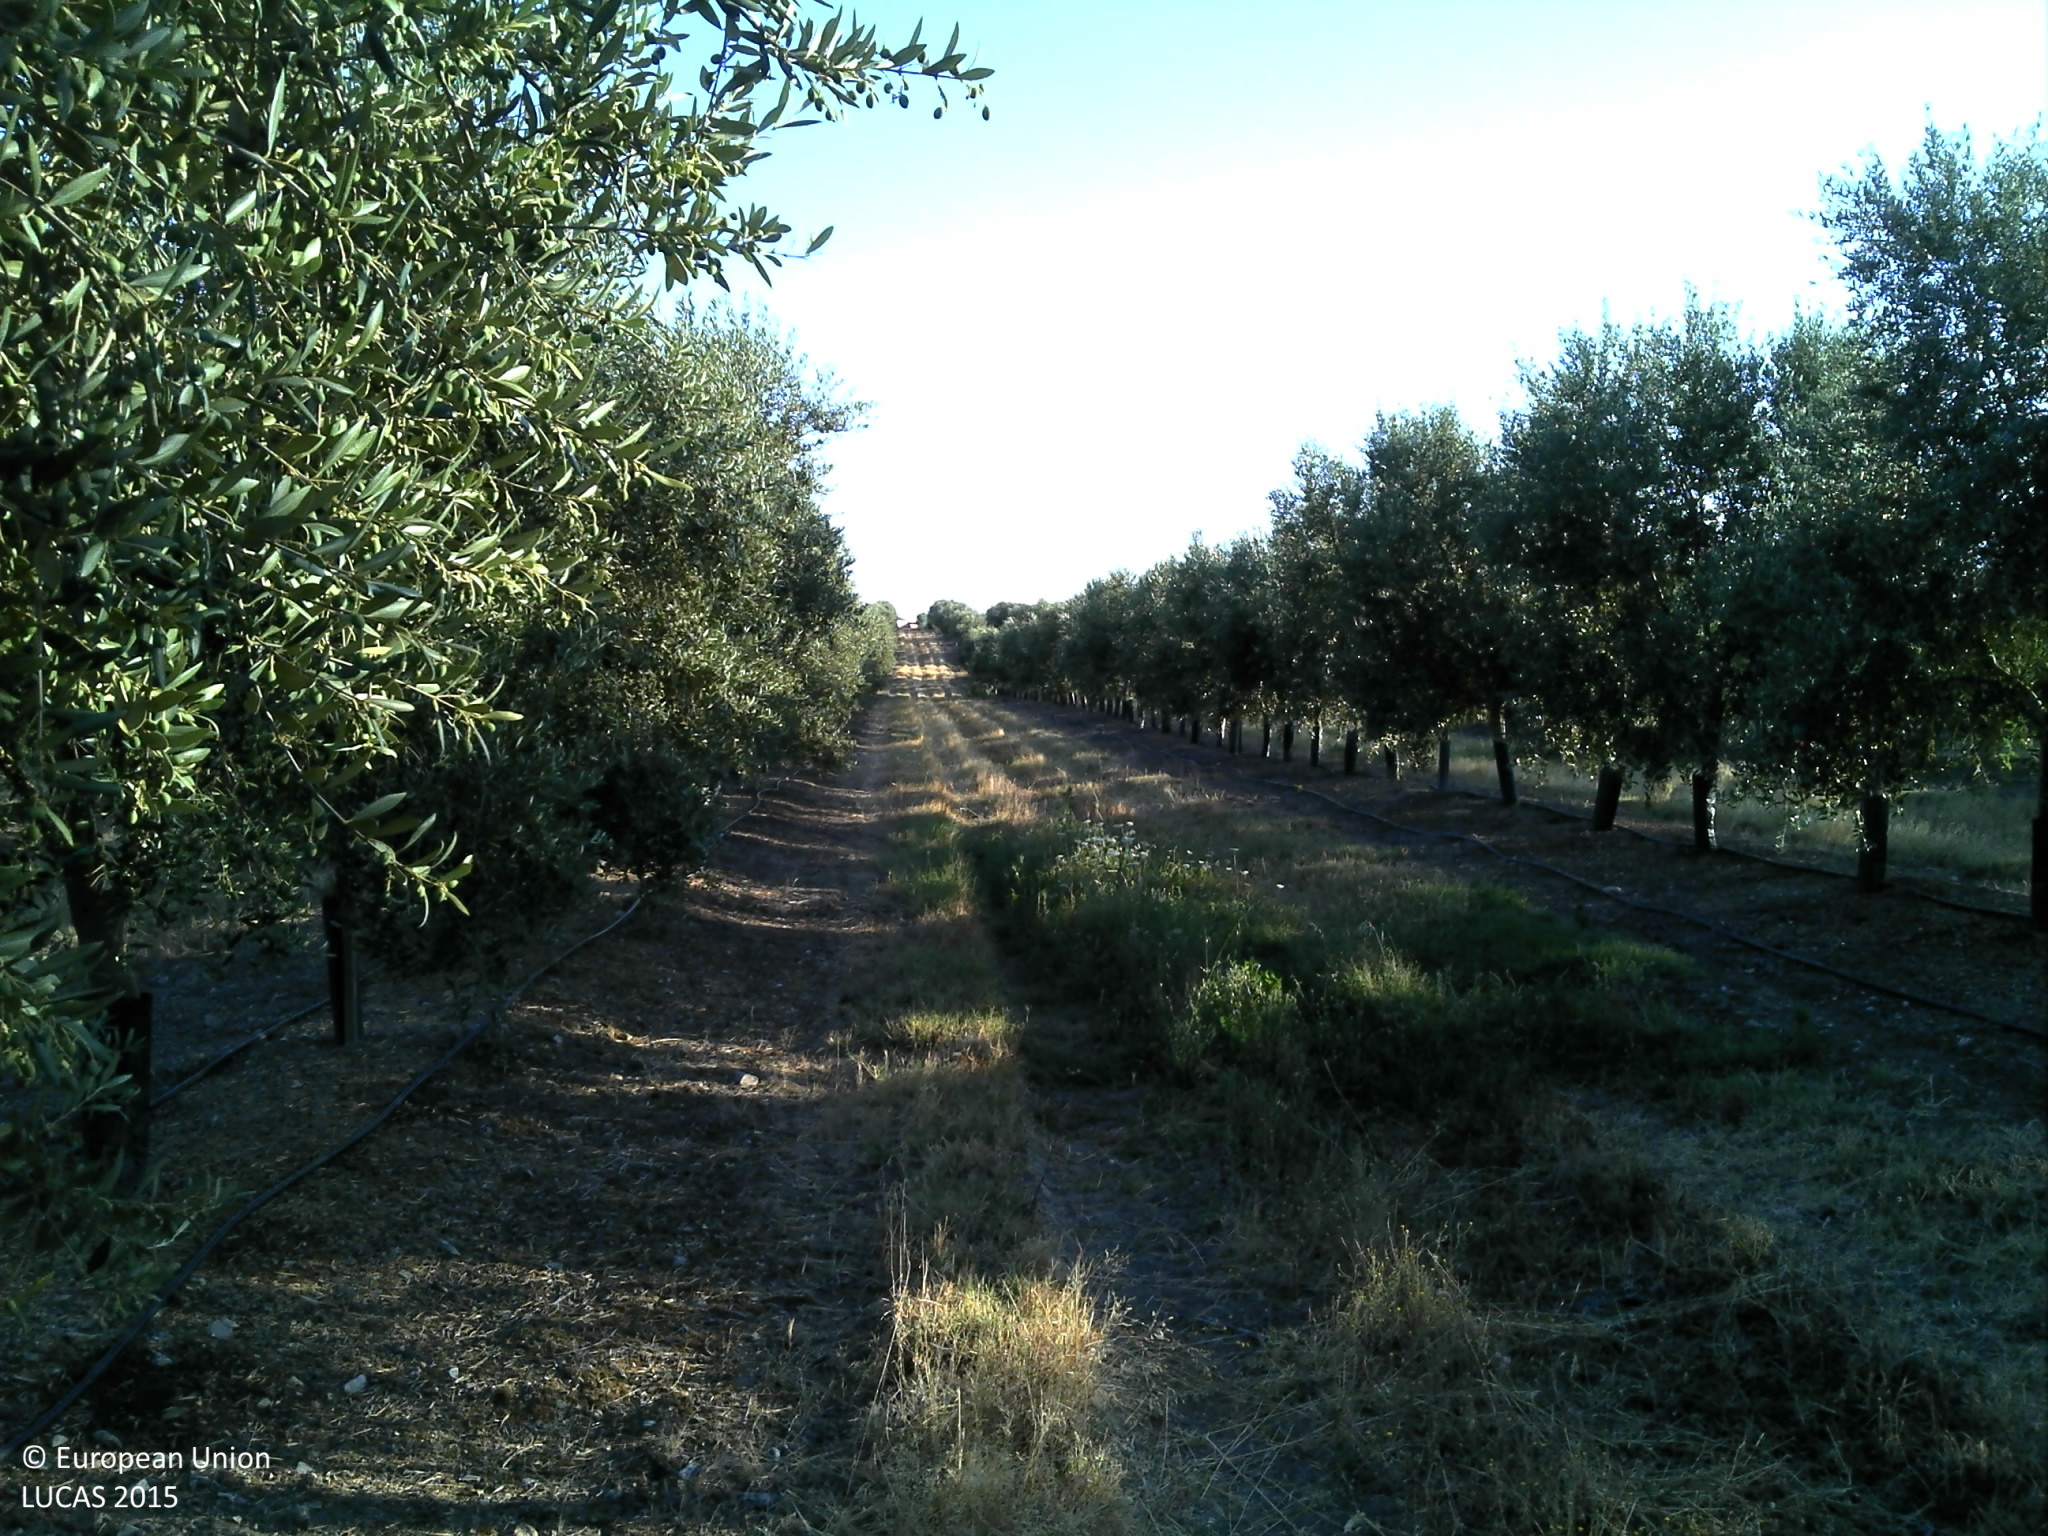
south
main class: Cropland
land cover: Olive groves
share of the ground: 25 - 50 %
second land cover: Spontaneously vegetated surfaces
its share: 10 - 25 %
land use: Agriculture (excluding fallow land and kitchen gardens)
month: June
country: PT
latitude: 38.1604
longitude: -8.1029
